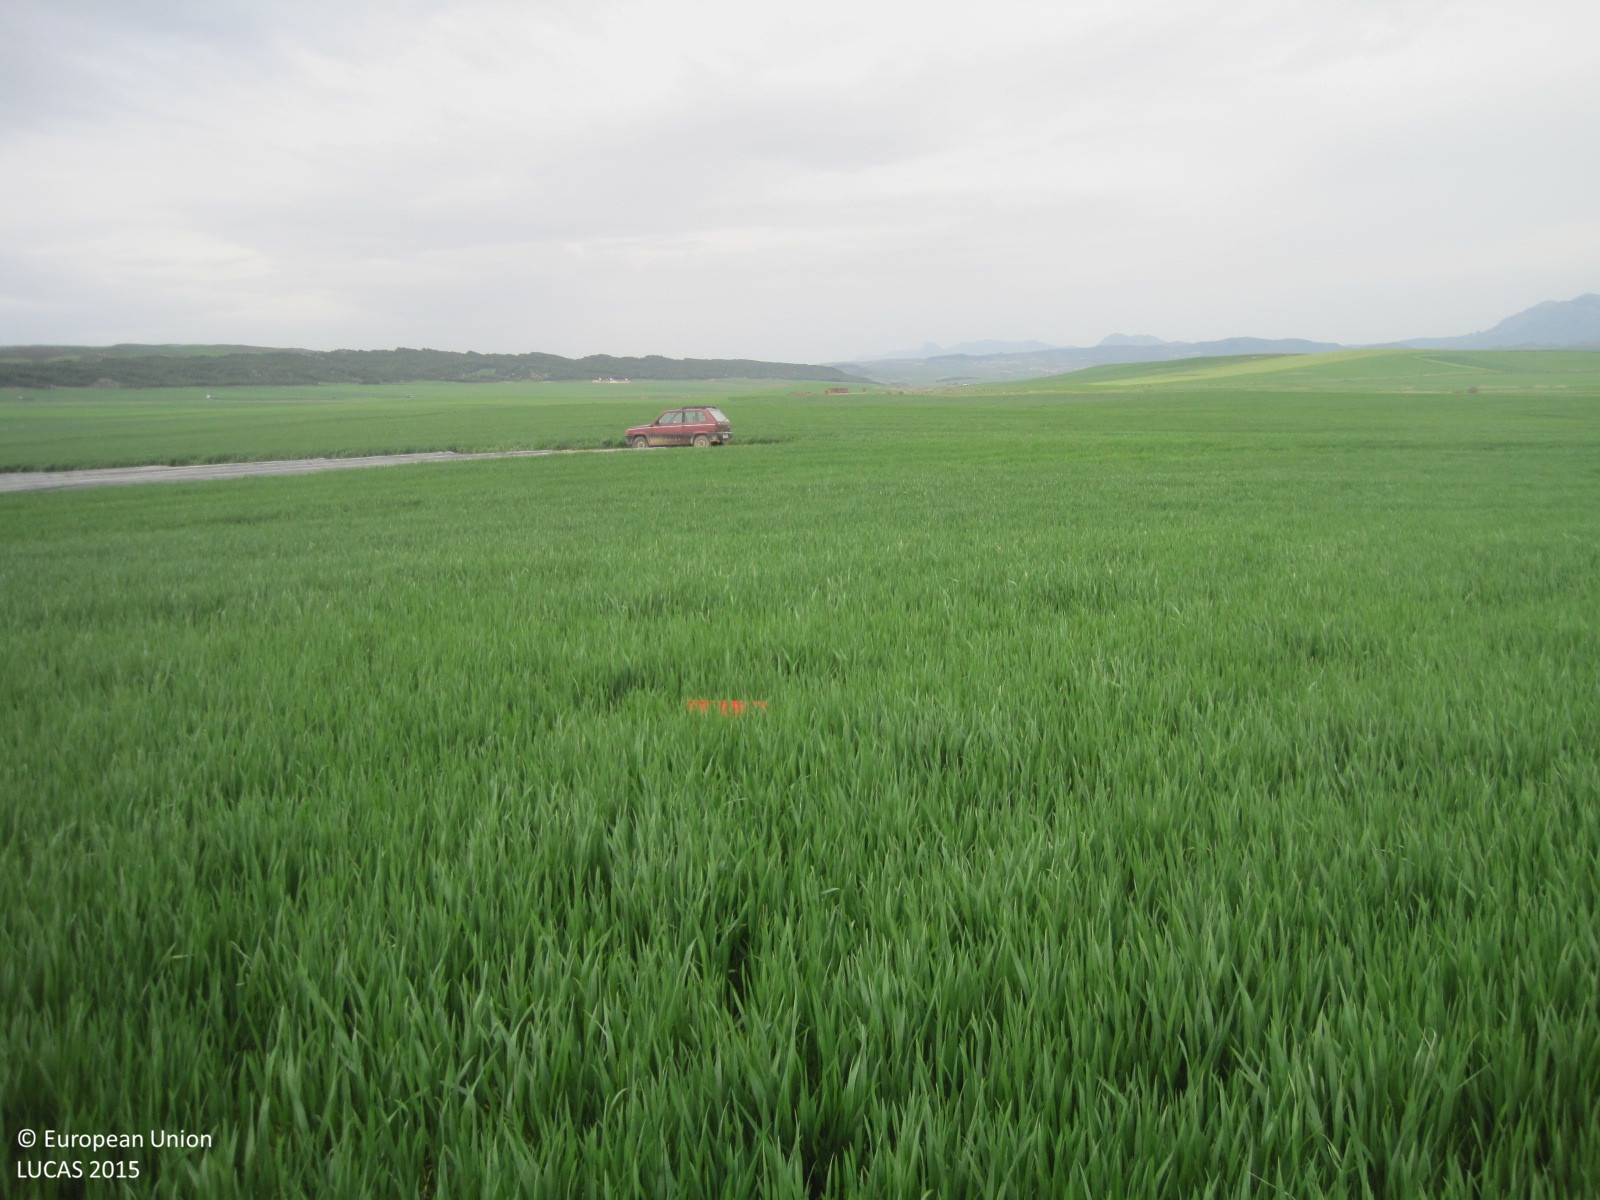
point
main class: Cropland
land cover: Barley
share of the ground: > 75 %
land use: Agriculture (excluding fallow land and kitchen gardens)
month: April
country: ES
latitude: 42.5241
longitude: -2.1297
